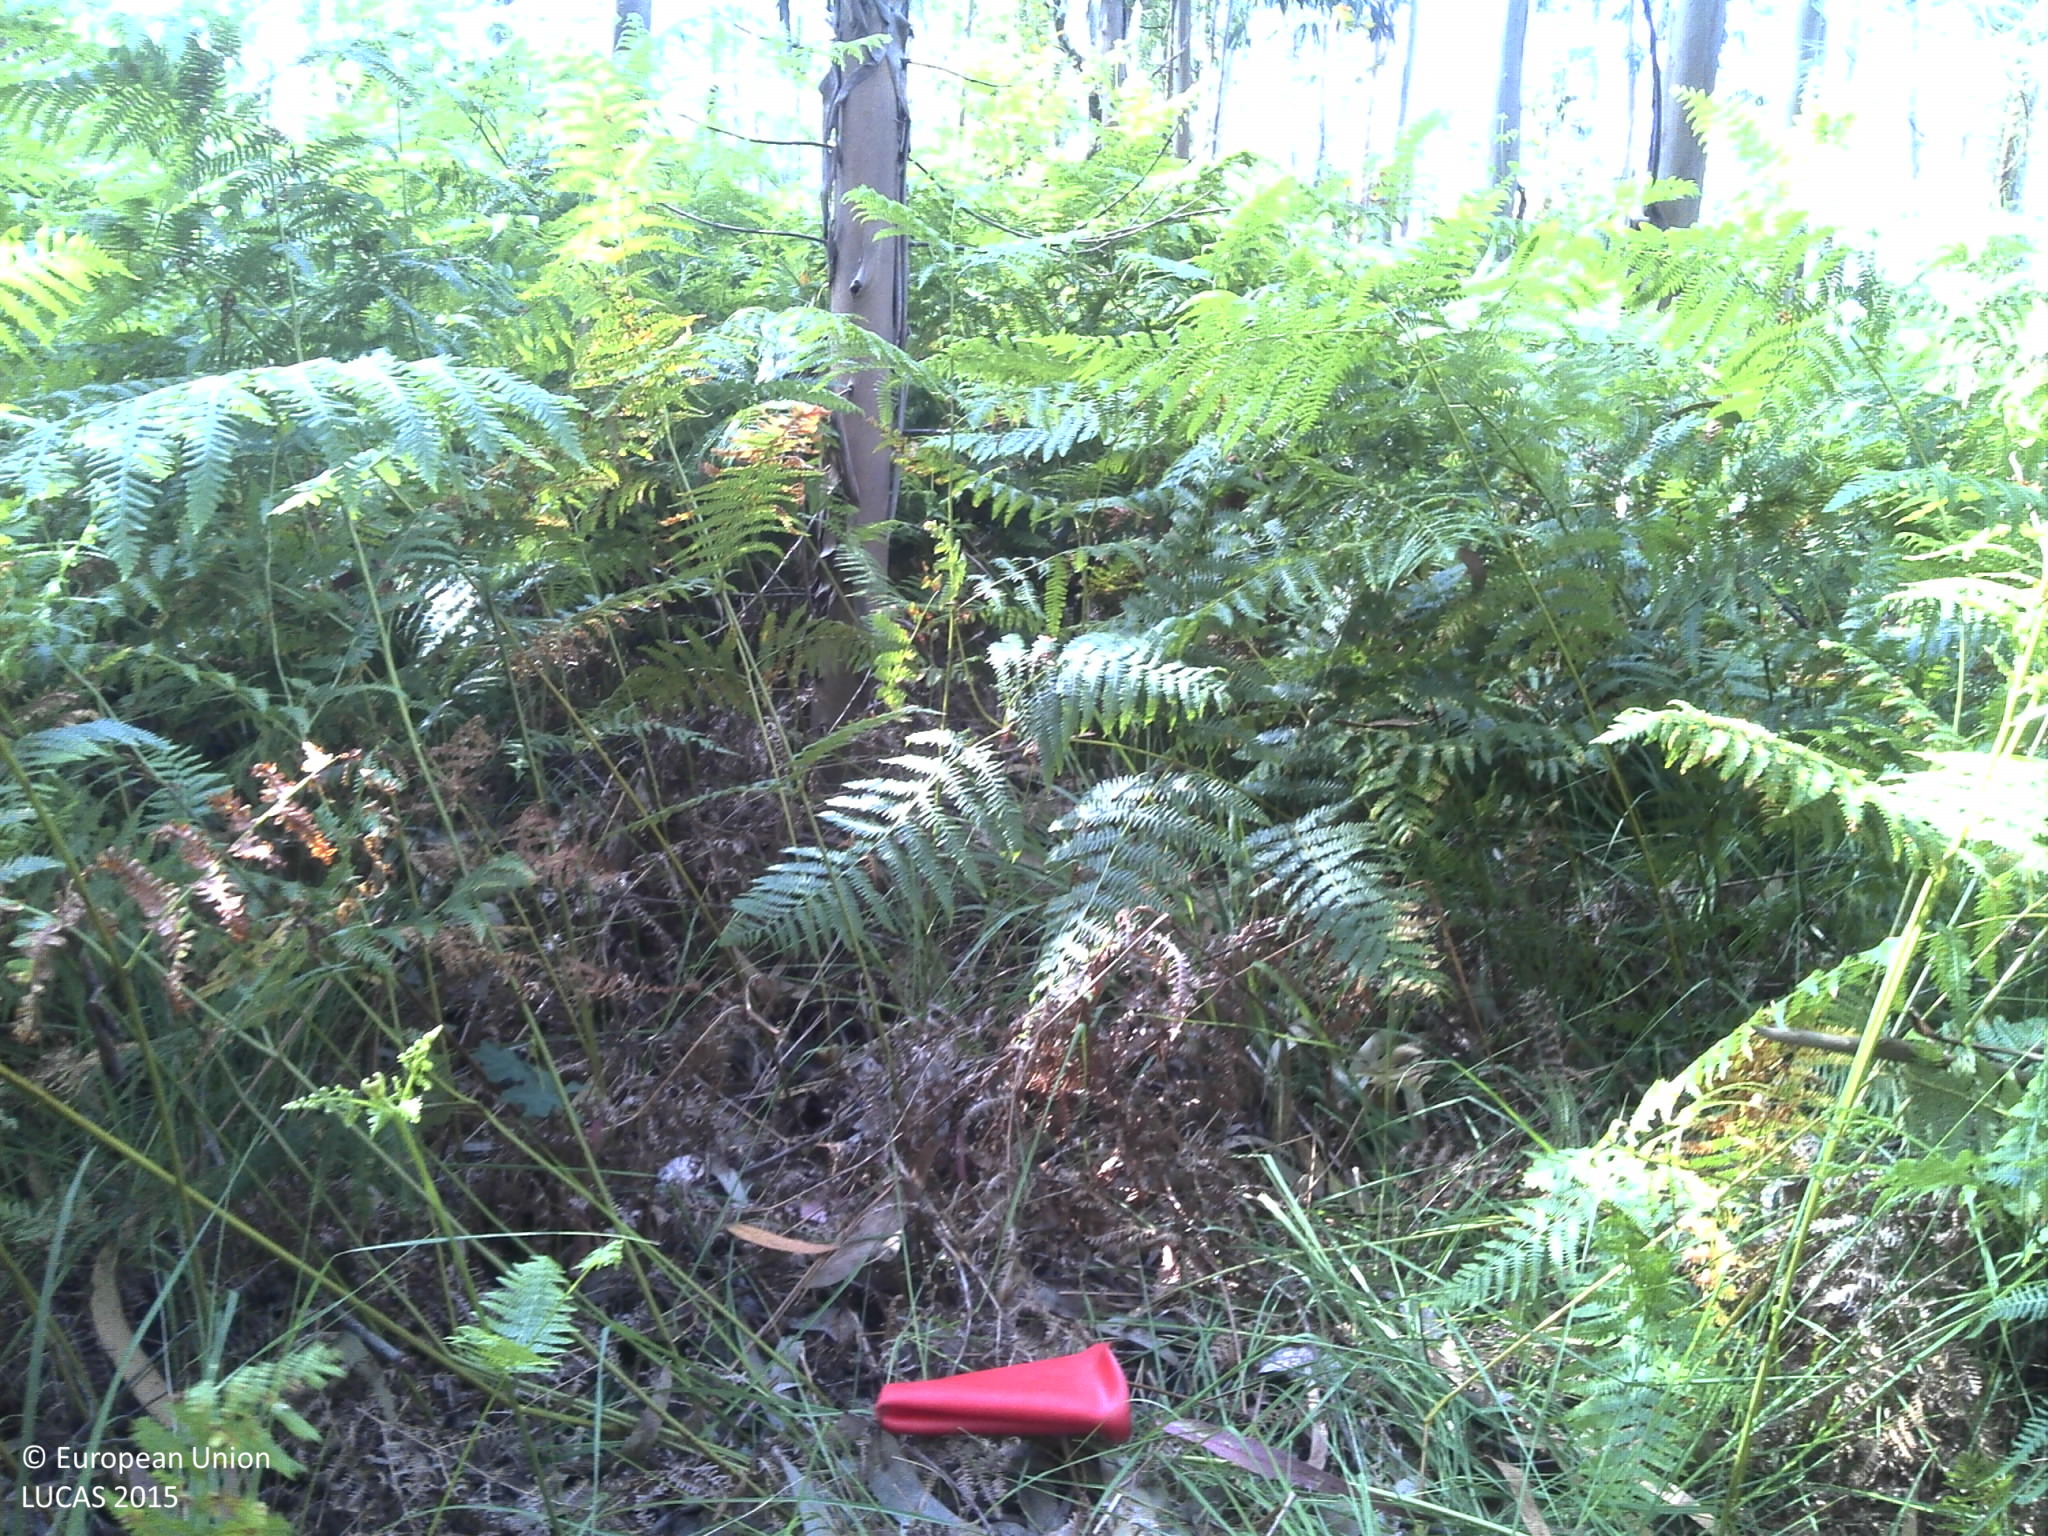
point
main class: Woodland
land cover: Broadleaved woodland
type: exotic forest
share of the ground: 50 - 75 %
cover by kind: broadleaved forest trees 70 %, shrubs 20 %, unconsolidated bare surface 10 %
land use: Forestry
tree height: > 5 m
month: June
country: PT
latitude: 40.8194
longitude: -8.5091
